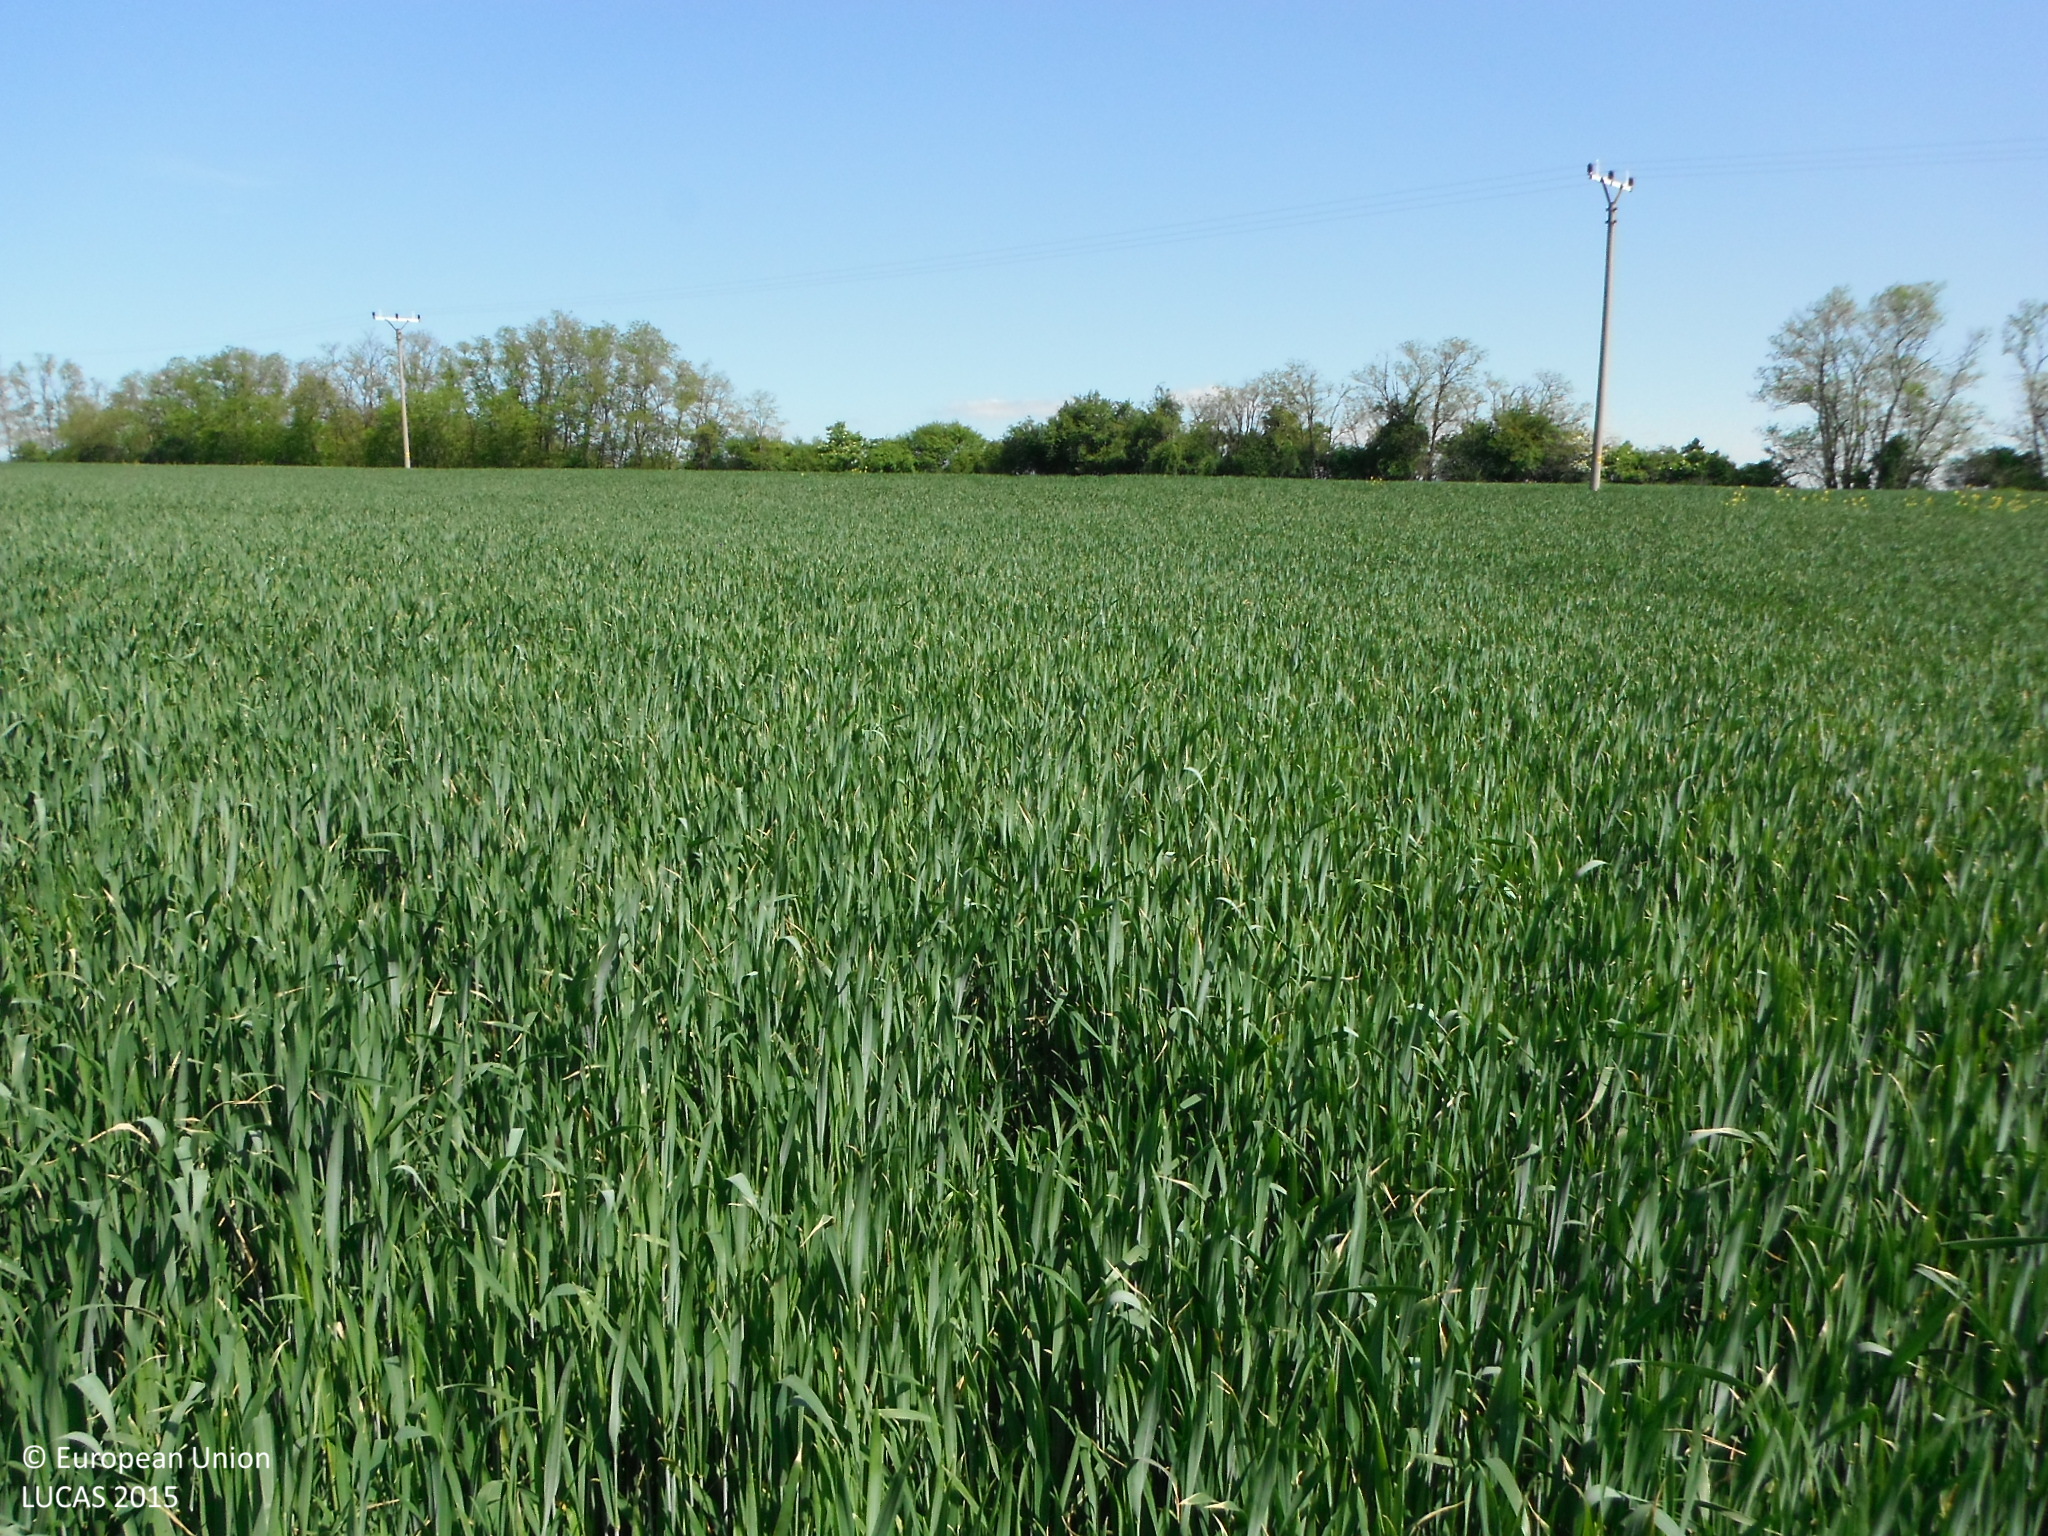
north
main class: Cropland
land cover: Common wheat
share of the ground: > 75 %
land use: Agriculture (excluding fallow land and kitchen gardens)
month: May
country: SK
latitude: 48.3295
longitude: 18.2563
